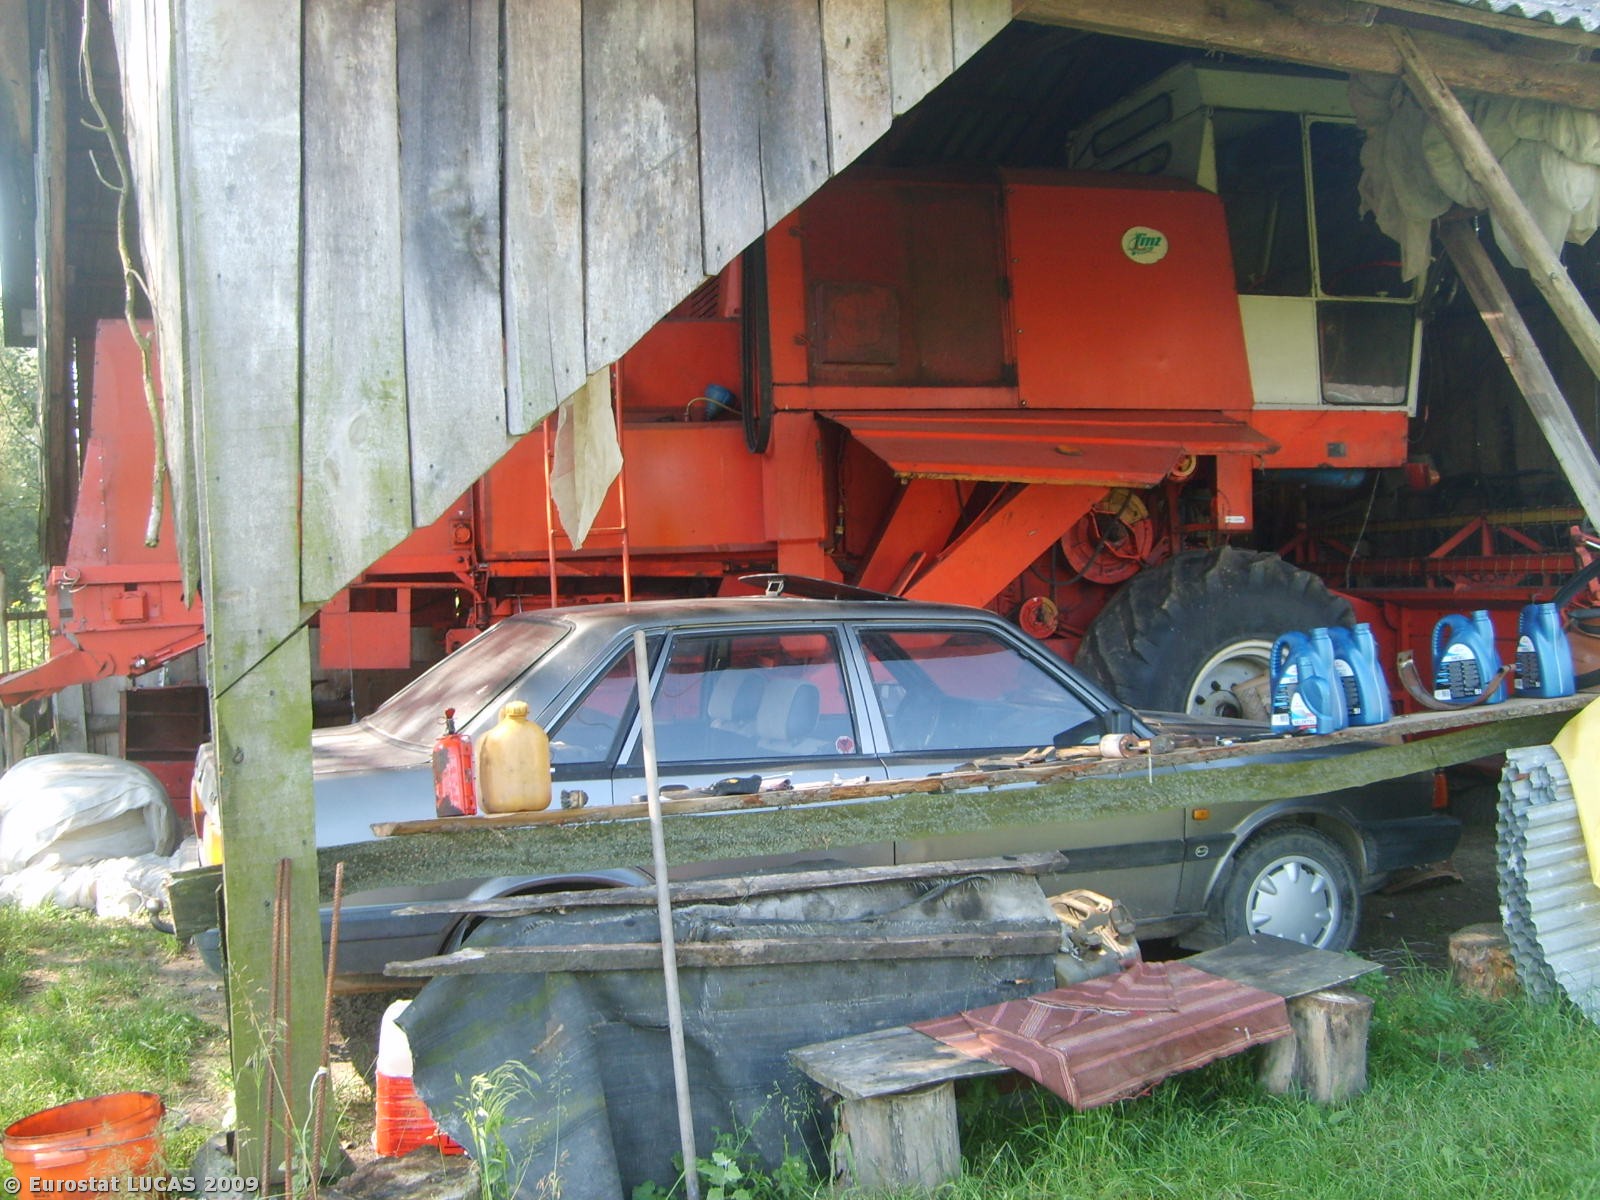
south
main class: Grassland
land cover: Grassland without tree/shrub cover
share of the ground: > 75 %
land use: Agriculture (excluding fallow land and kitchen gardens)
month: July
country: PL
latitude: 50.3602
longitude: 21.1650
